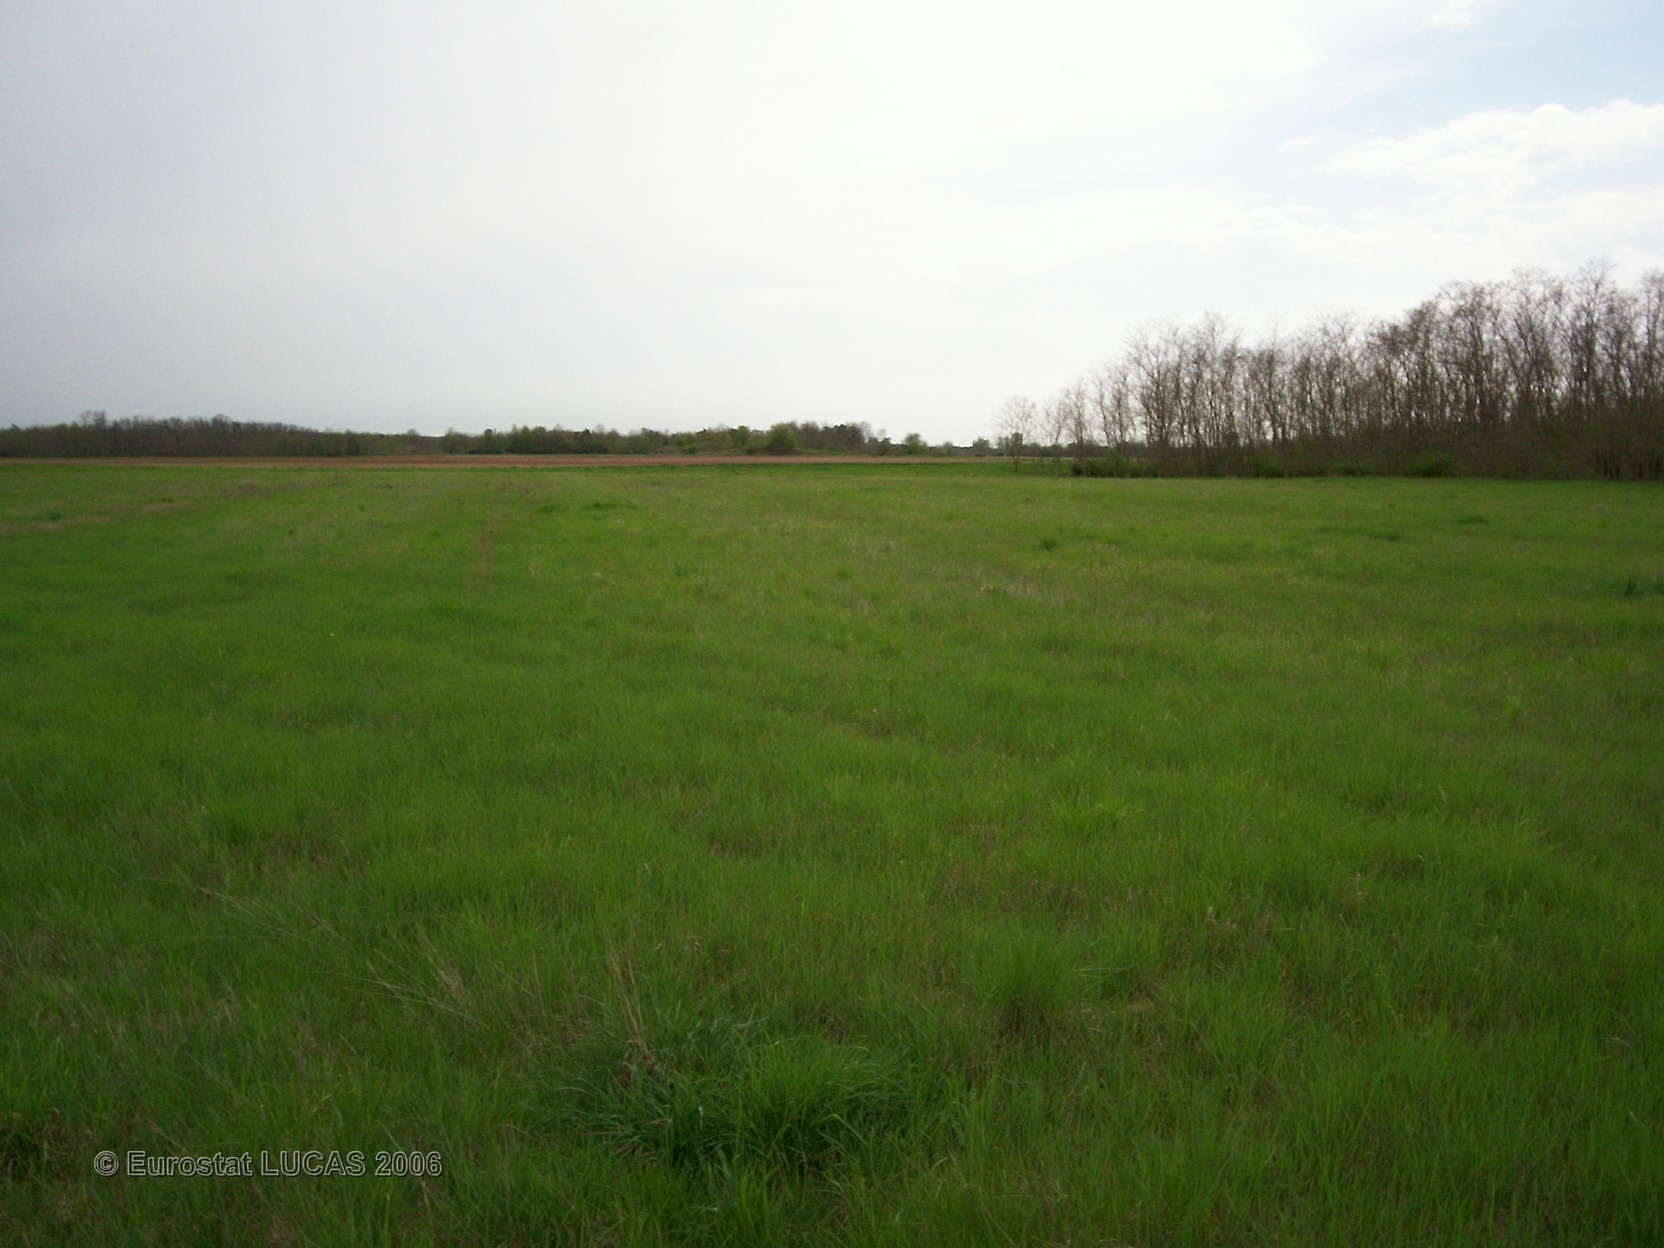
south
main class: Grassland
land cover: Grassland without tree/shrub cover
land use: Agriculture (excluding fallow land and kitchen gardens)
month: April
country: FR
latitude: 47.9412
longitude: 7.4175
